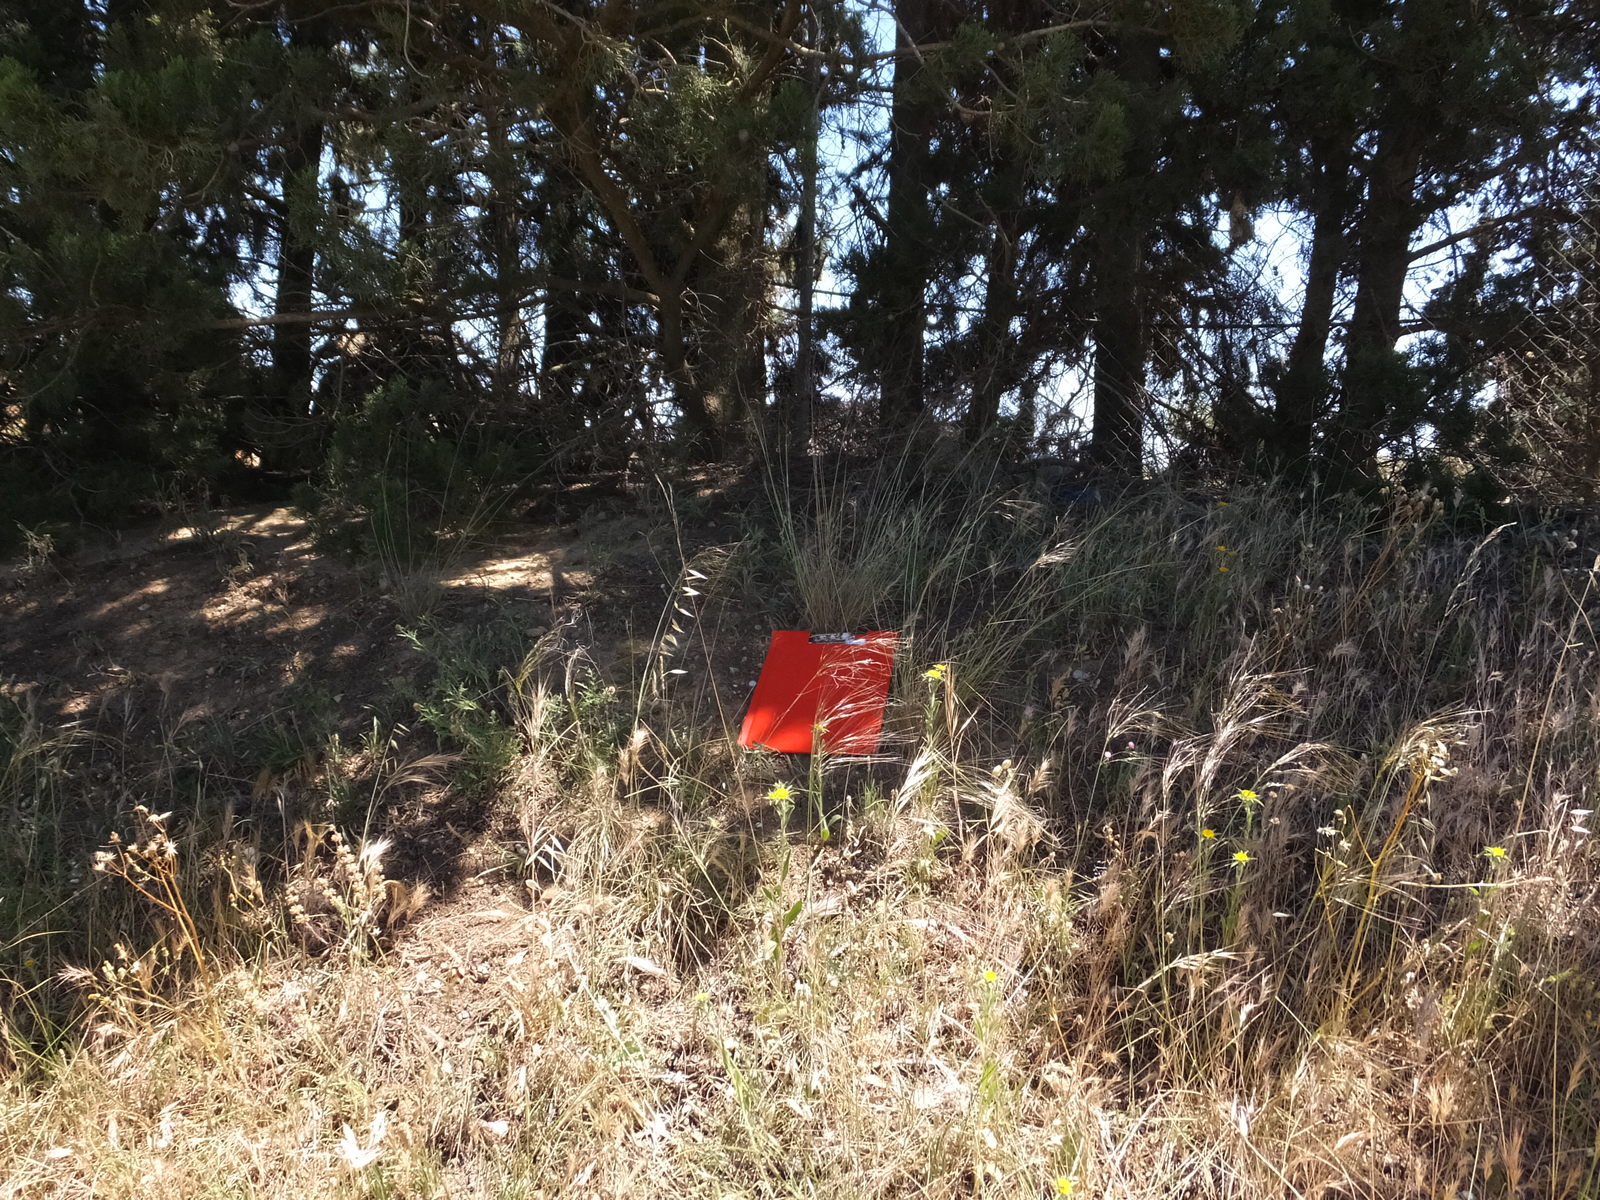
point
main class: Grassland
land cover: Grassland with sparse tree/shrub cover
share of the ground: > 75 %
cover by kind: herbaceous plants 85 %, shrubs 10 %, coniferous forest trees 5 %
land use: Construction
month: May
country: ES
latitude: 41.8138
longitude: -0.1661
